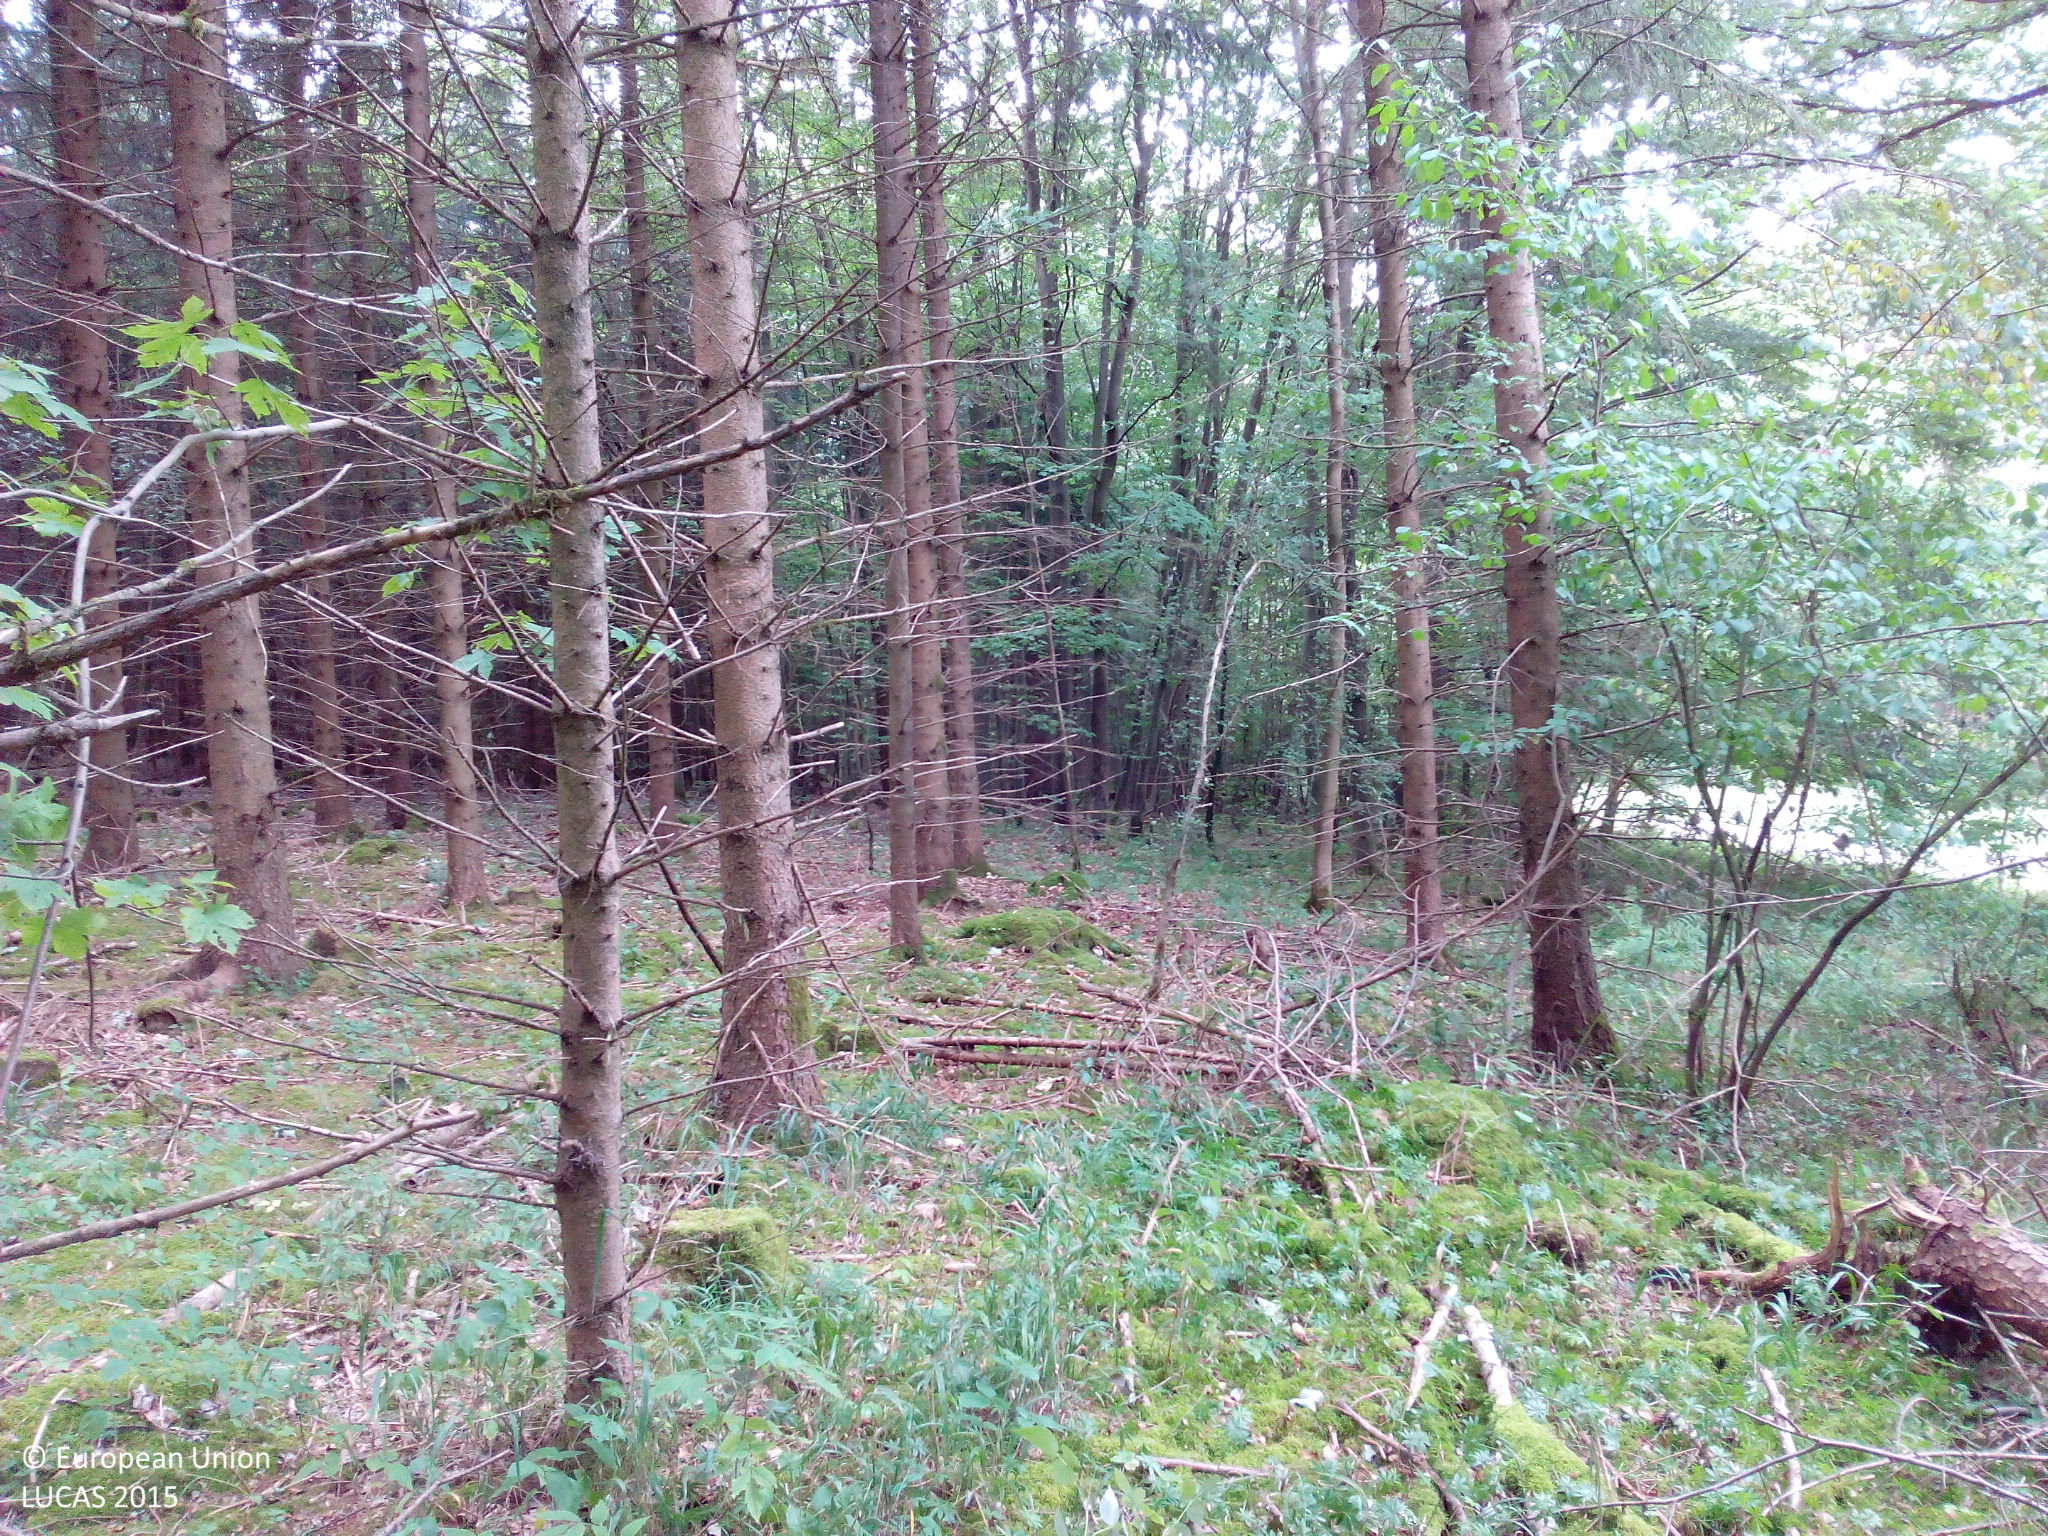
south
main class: Woodland
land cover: Spruce dominated mixed woodland
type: hemiboreal forest and nemoral coniferous forest and mixed broadleaved-coniferous forest
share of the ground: > 75 %
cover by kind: coniferous forest trees 45 %, broadleaved forest trees 30 %, lichens and mosses 15 %, shrubs 5 %, herbaceous plants 5 %
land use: Forestry
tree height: > 5 m
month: July
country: DE
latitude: 48.8169
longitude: 10.3131
